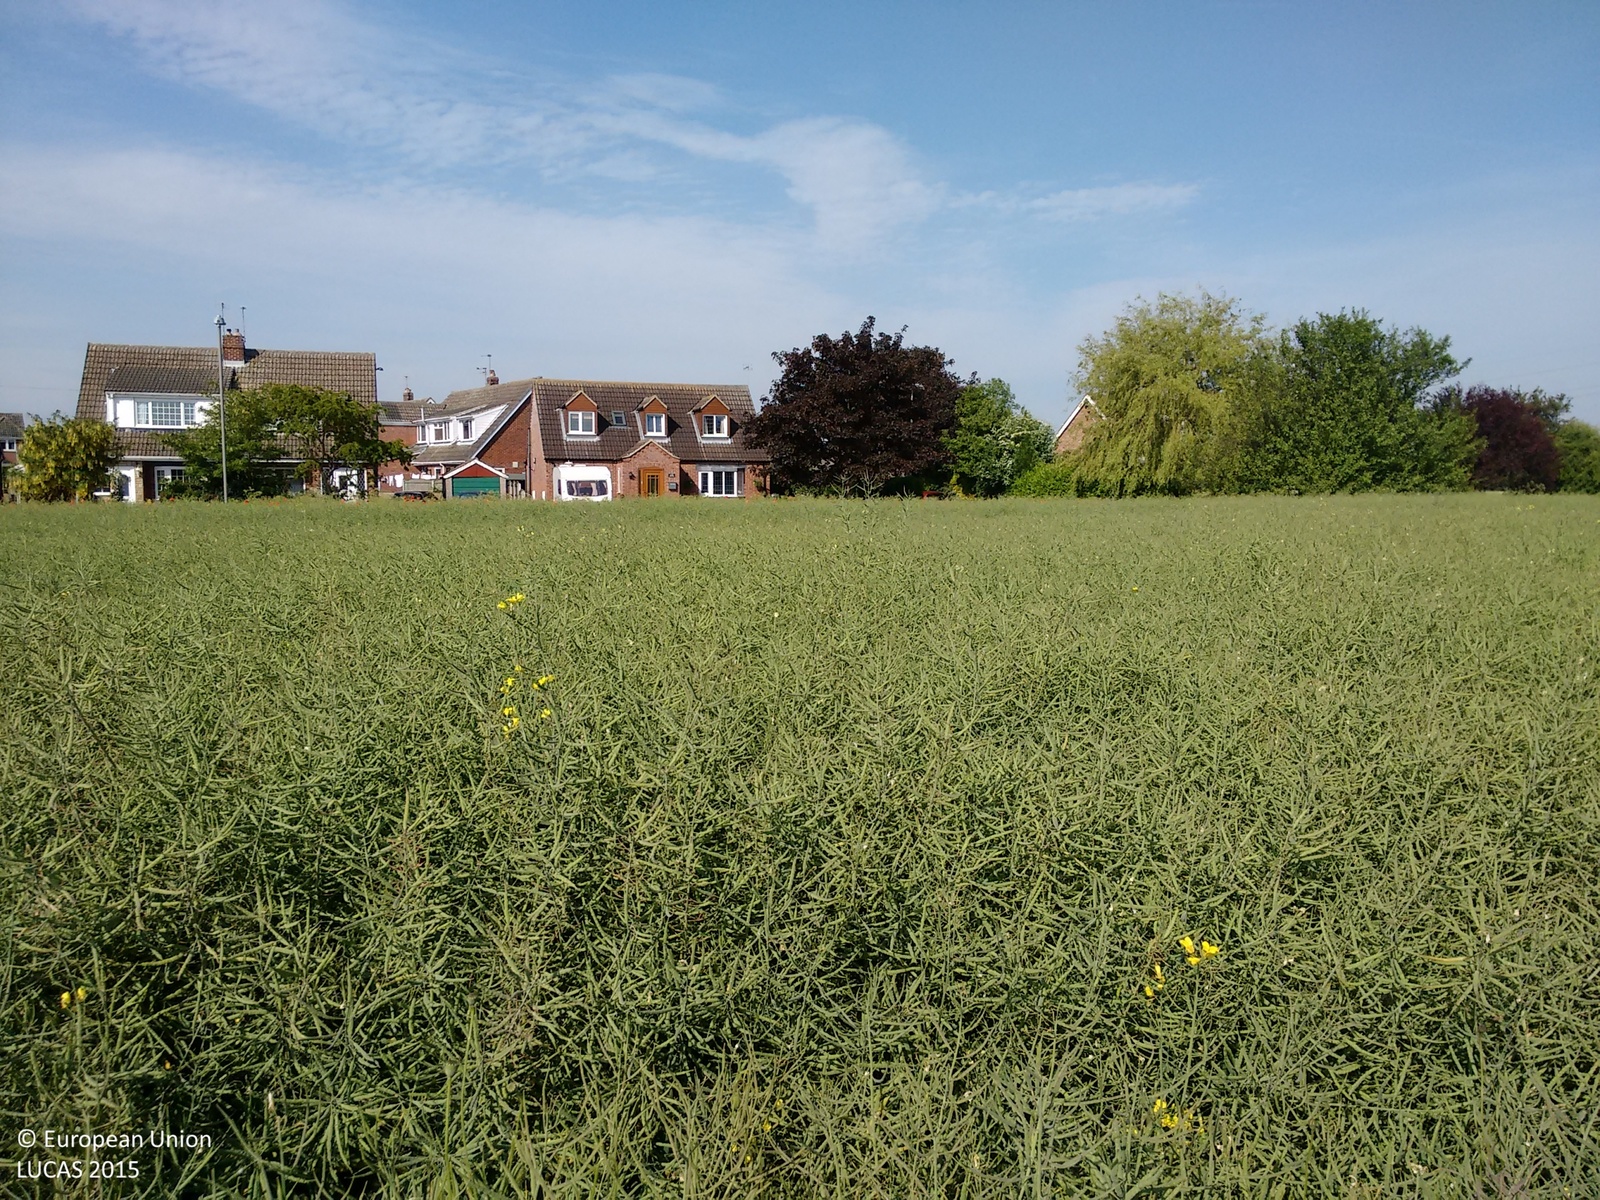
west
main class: Cropland
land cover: Rape and turnip rape
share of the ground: > 75 %
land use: Agriculture (excluding fallow land and kitchen gardens)
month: June
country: GB
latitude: 53.7733
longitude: -1.1672
